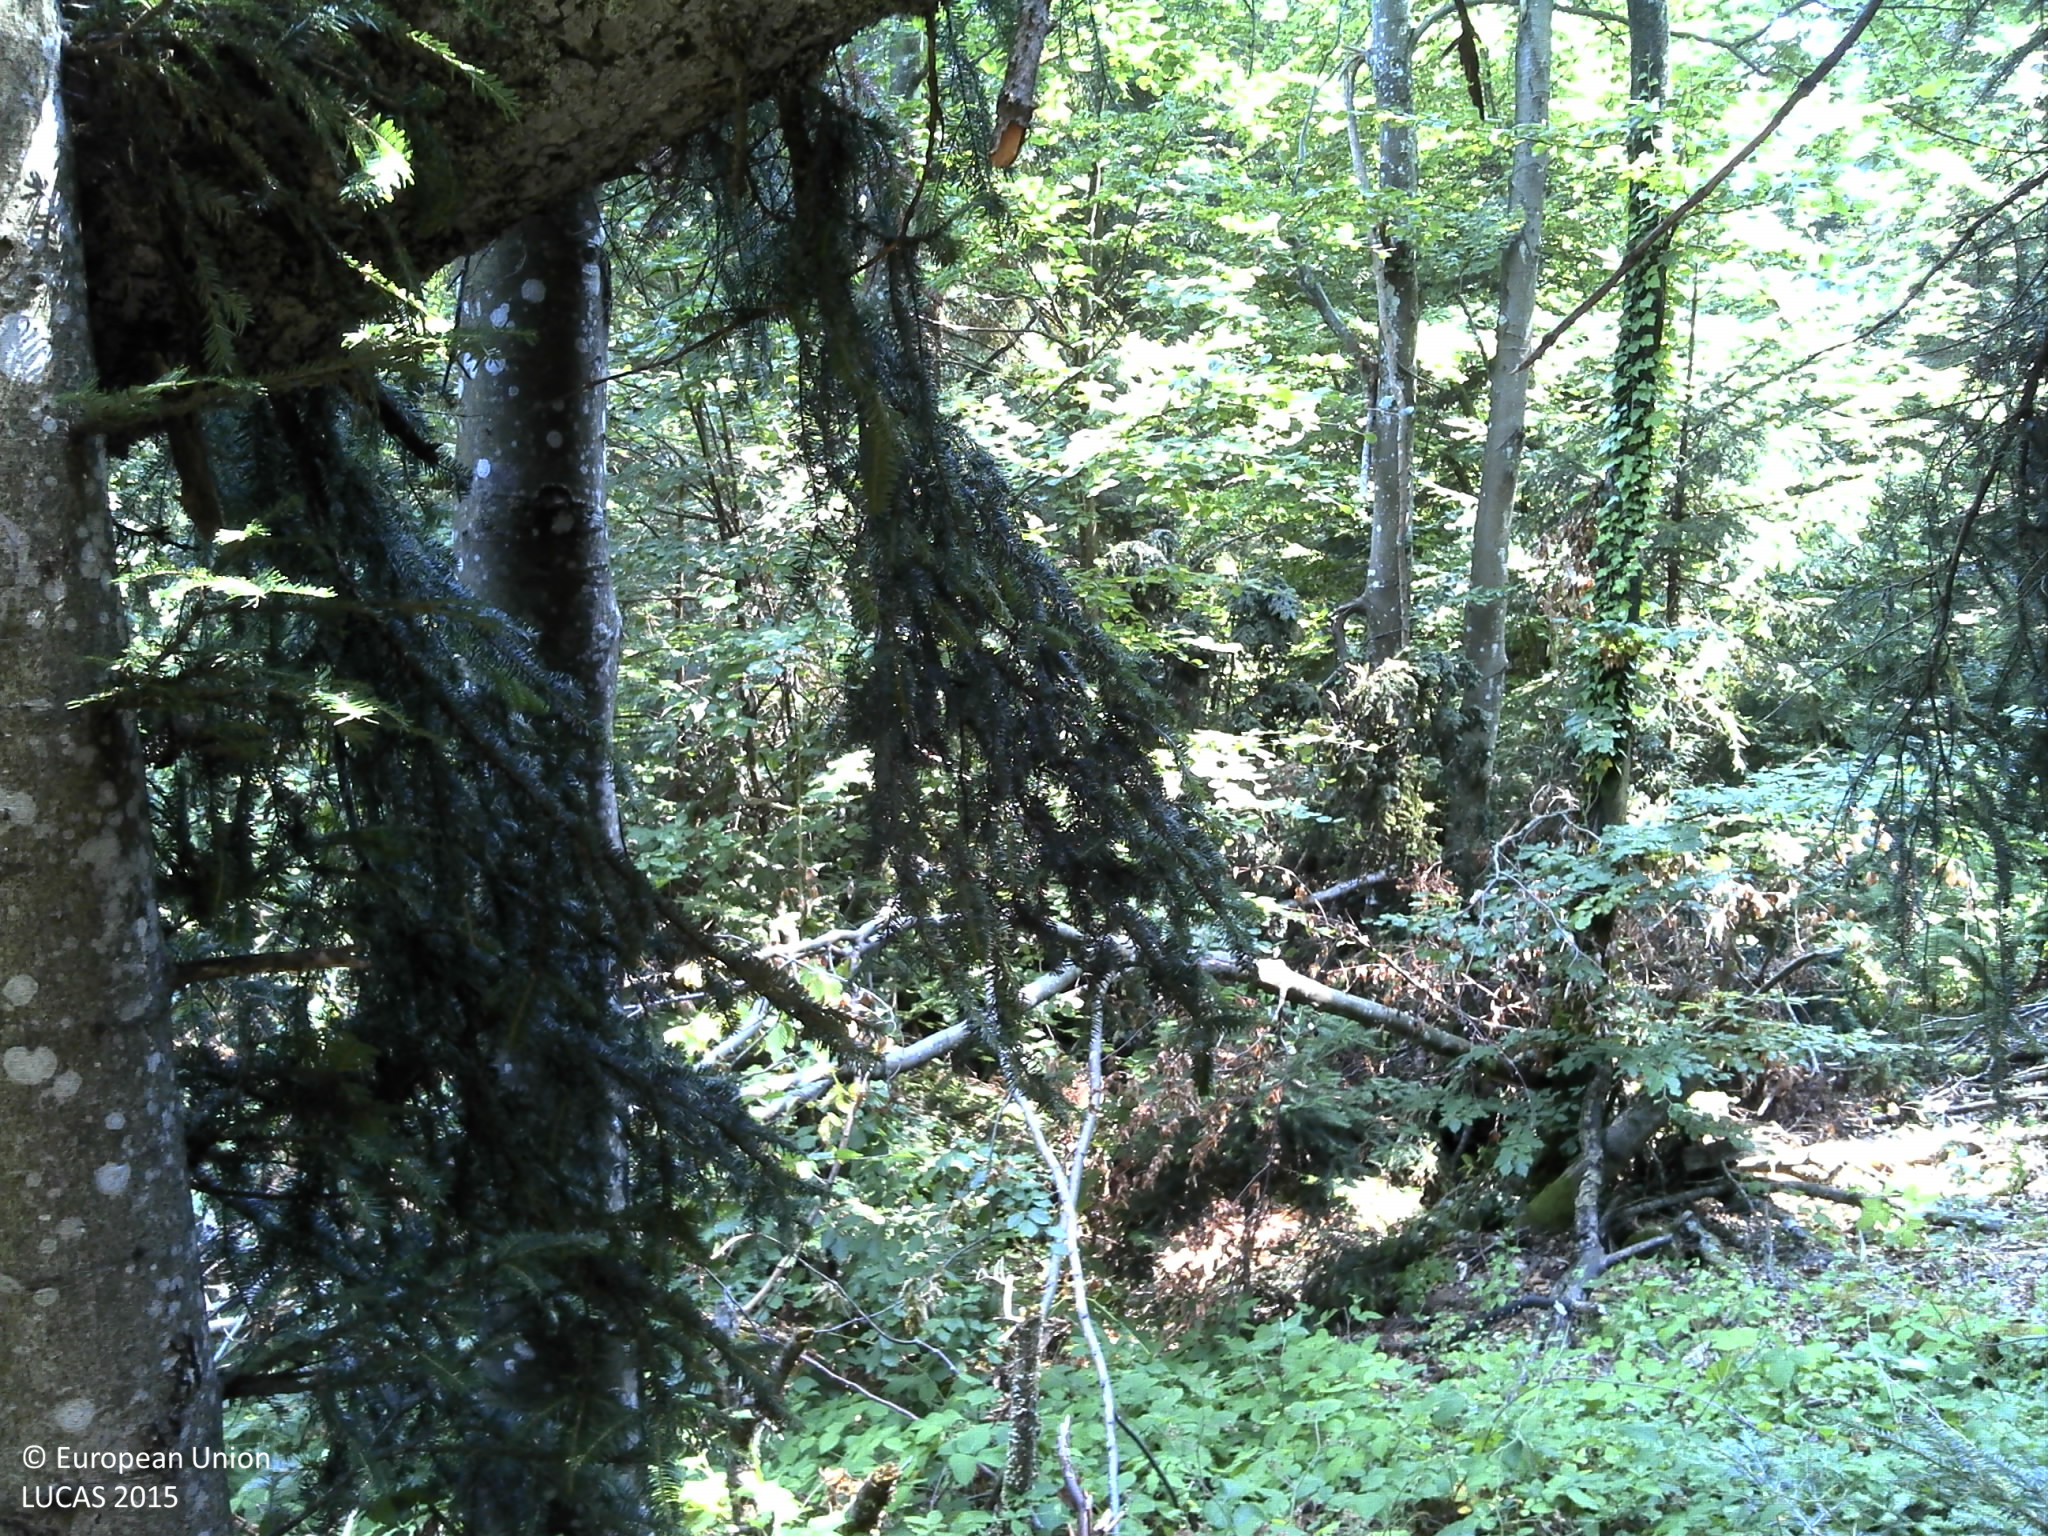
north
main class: Woodland
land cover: Spruce dominated mixed woodland
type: alpine coniferous forest
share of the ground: > 75 %
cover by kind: coniferous forest trees 50 %, broadleaved forest trees 30 %, shrubs 10 %, lichens and mosses 5 %, consolidated bare surface 5 %
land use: Forestry
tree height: > 5 m
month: July
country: HR
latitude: 45.0134
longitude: 15.2351
